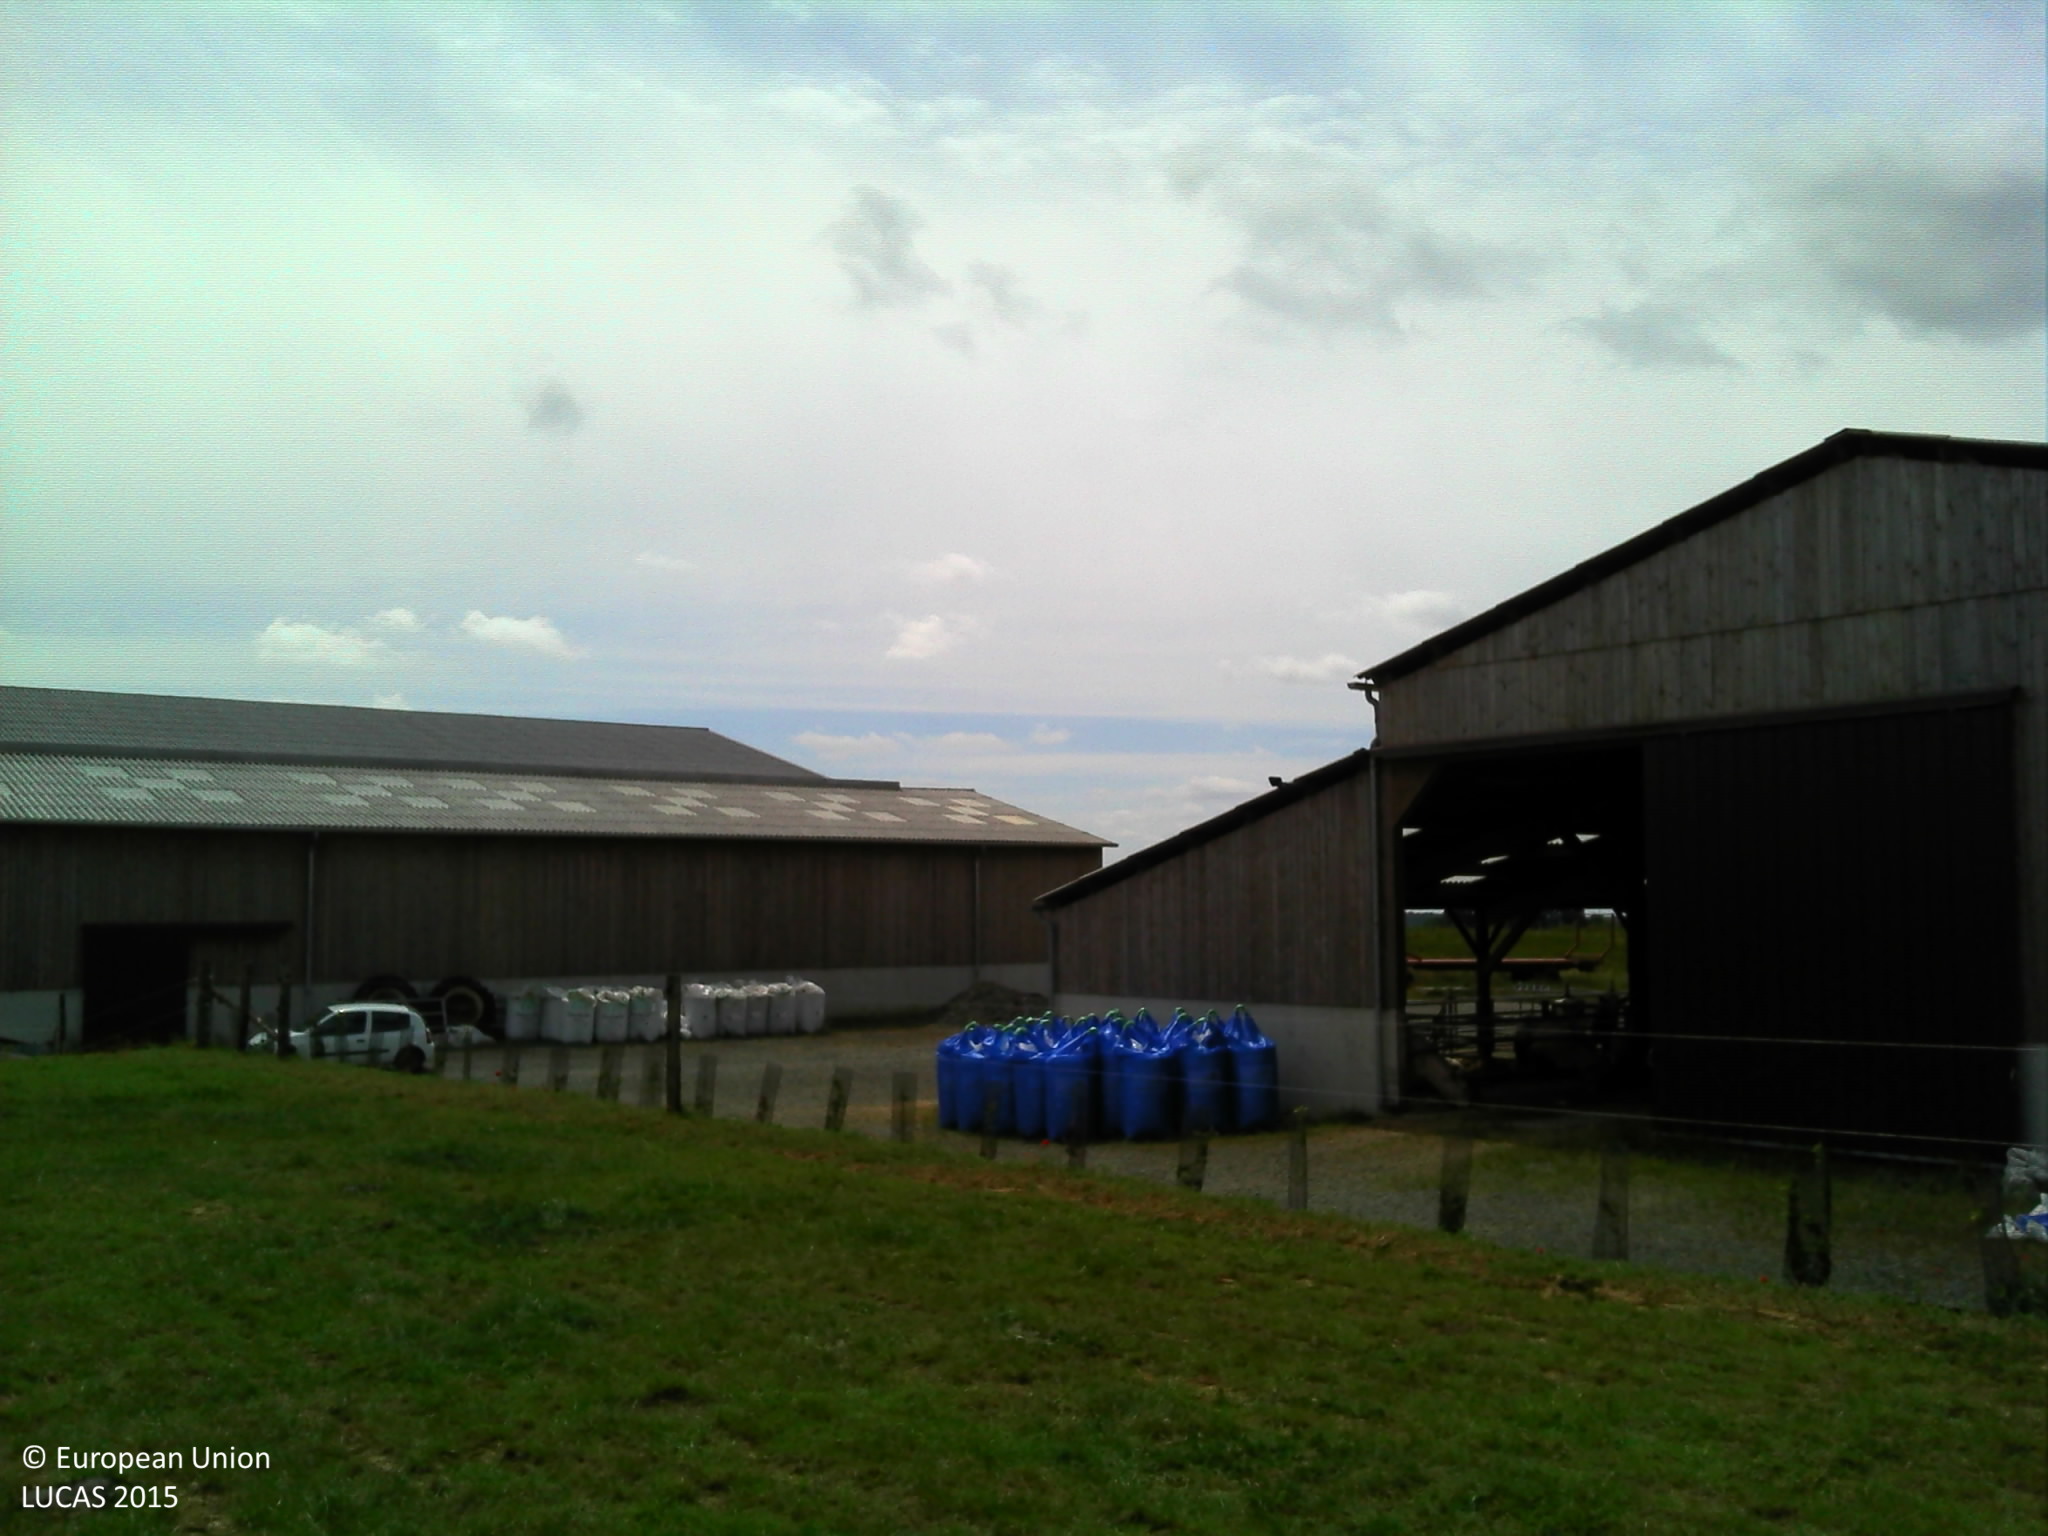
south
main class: Grassland
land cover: Grassland without tree/shrub cover
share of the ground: > 75 %
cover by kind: herbaceous plants 100 %
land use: Agriculture (excluding fallow land and kitchen gardens)
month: May
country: FR
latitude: 47.9868
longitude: 0.0167
